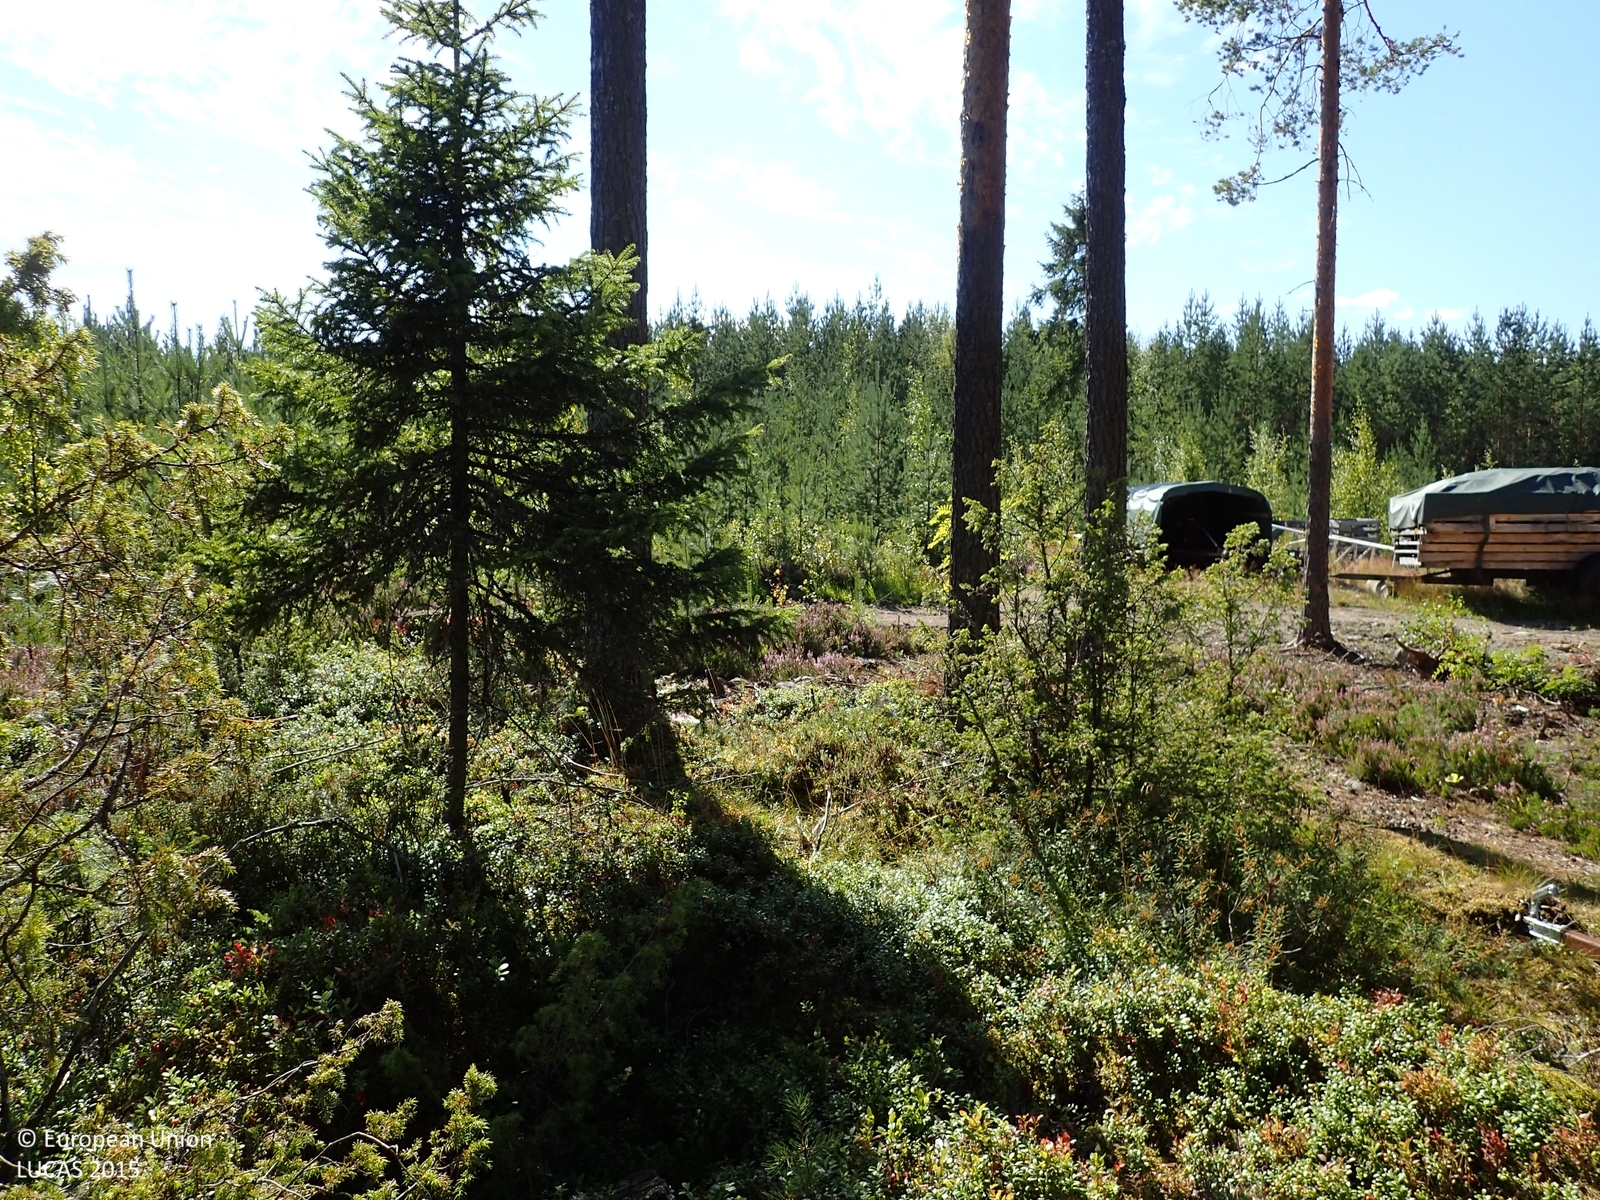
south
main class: Woodland
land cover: Pine dominated coniferous woodland
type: boreal forest
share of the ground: 50 - 75 %
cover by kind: coniferous forest trees 60 %, shrubs 40 %
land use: Forestry
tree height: > 5 m
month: August
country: FI
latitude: 62.4901
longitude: 22.2983
